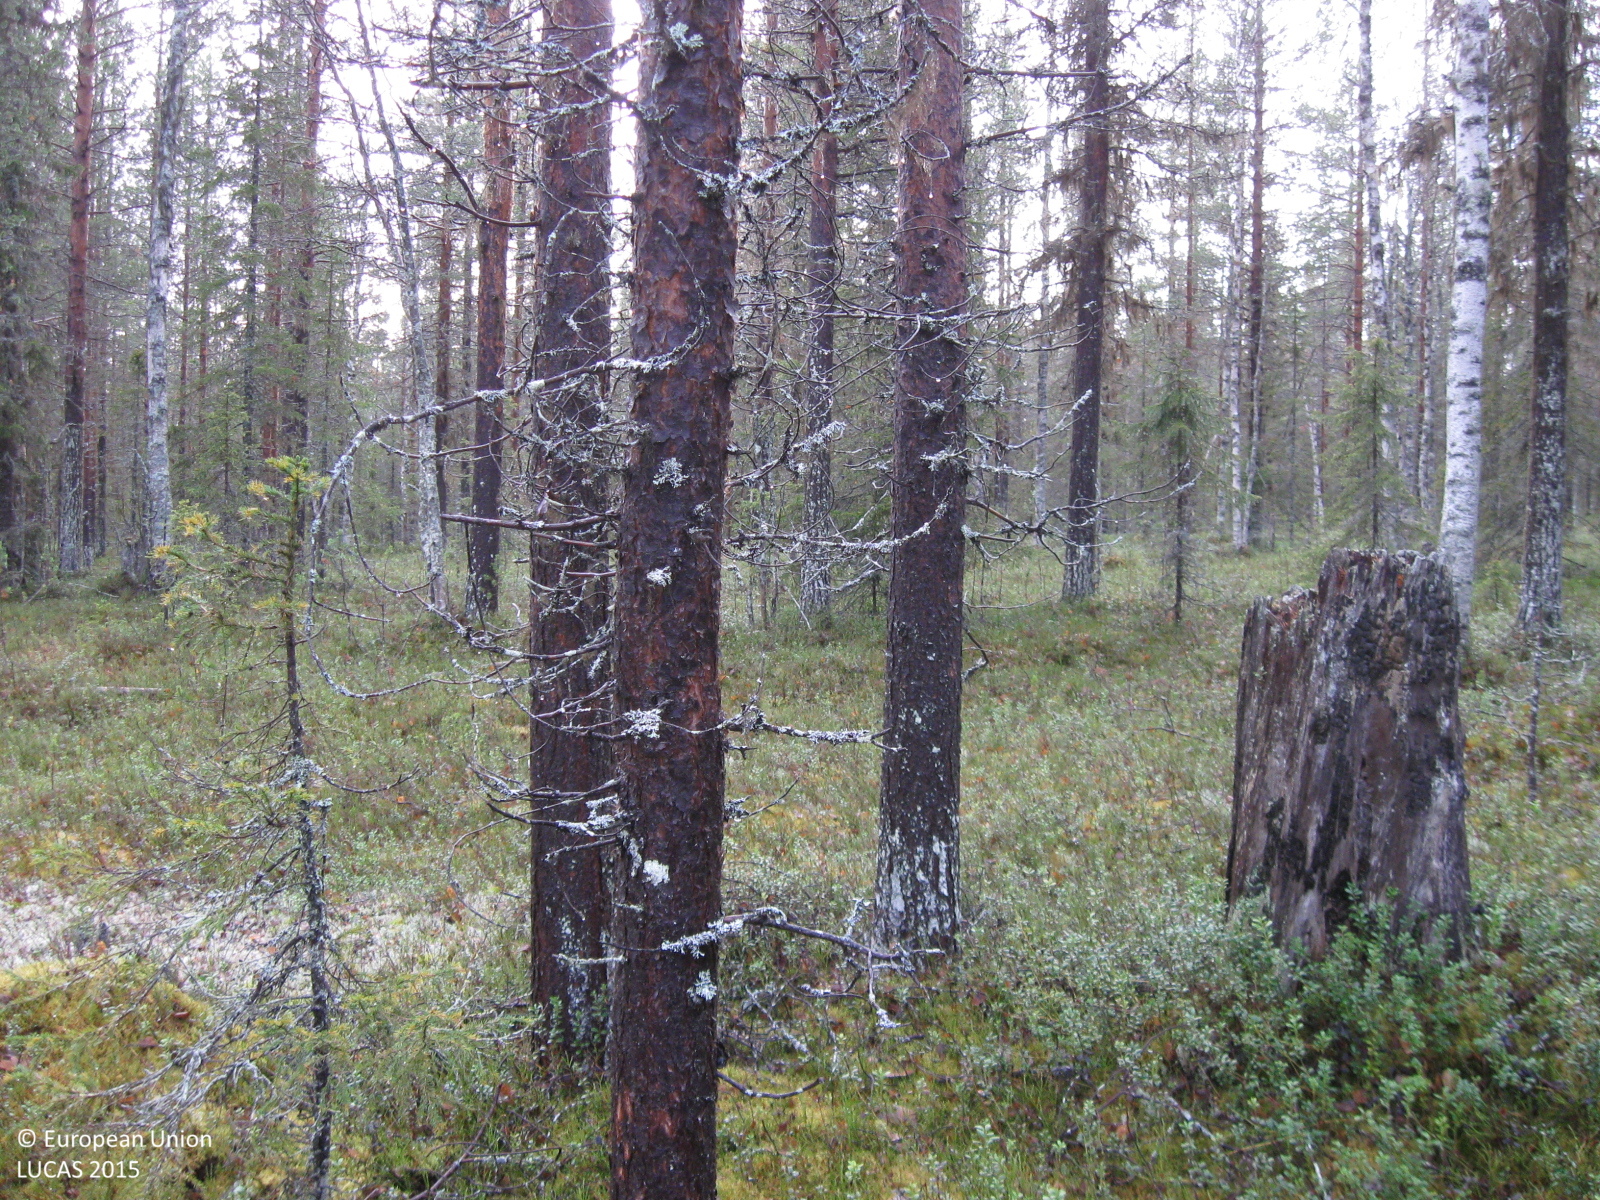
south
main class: Woodland
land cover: Pine dominated coniferous woodland
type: boreal forest
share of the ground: 50 - 75 %
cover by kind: coniferous forest trees 60 %, broadleaved forest trees 15 %, shrubs 10 %, lichens and mosses 10 %, herbaceous plants 5 %
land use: Forestry
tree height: > 5 m
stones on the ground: > 50 %
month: October
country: SE
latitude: 66.5082
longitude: 20.9068
